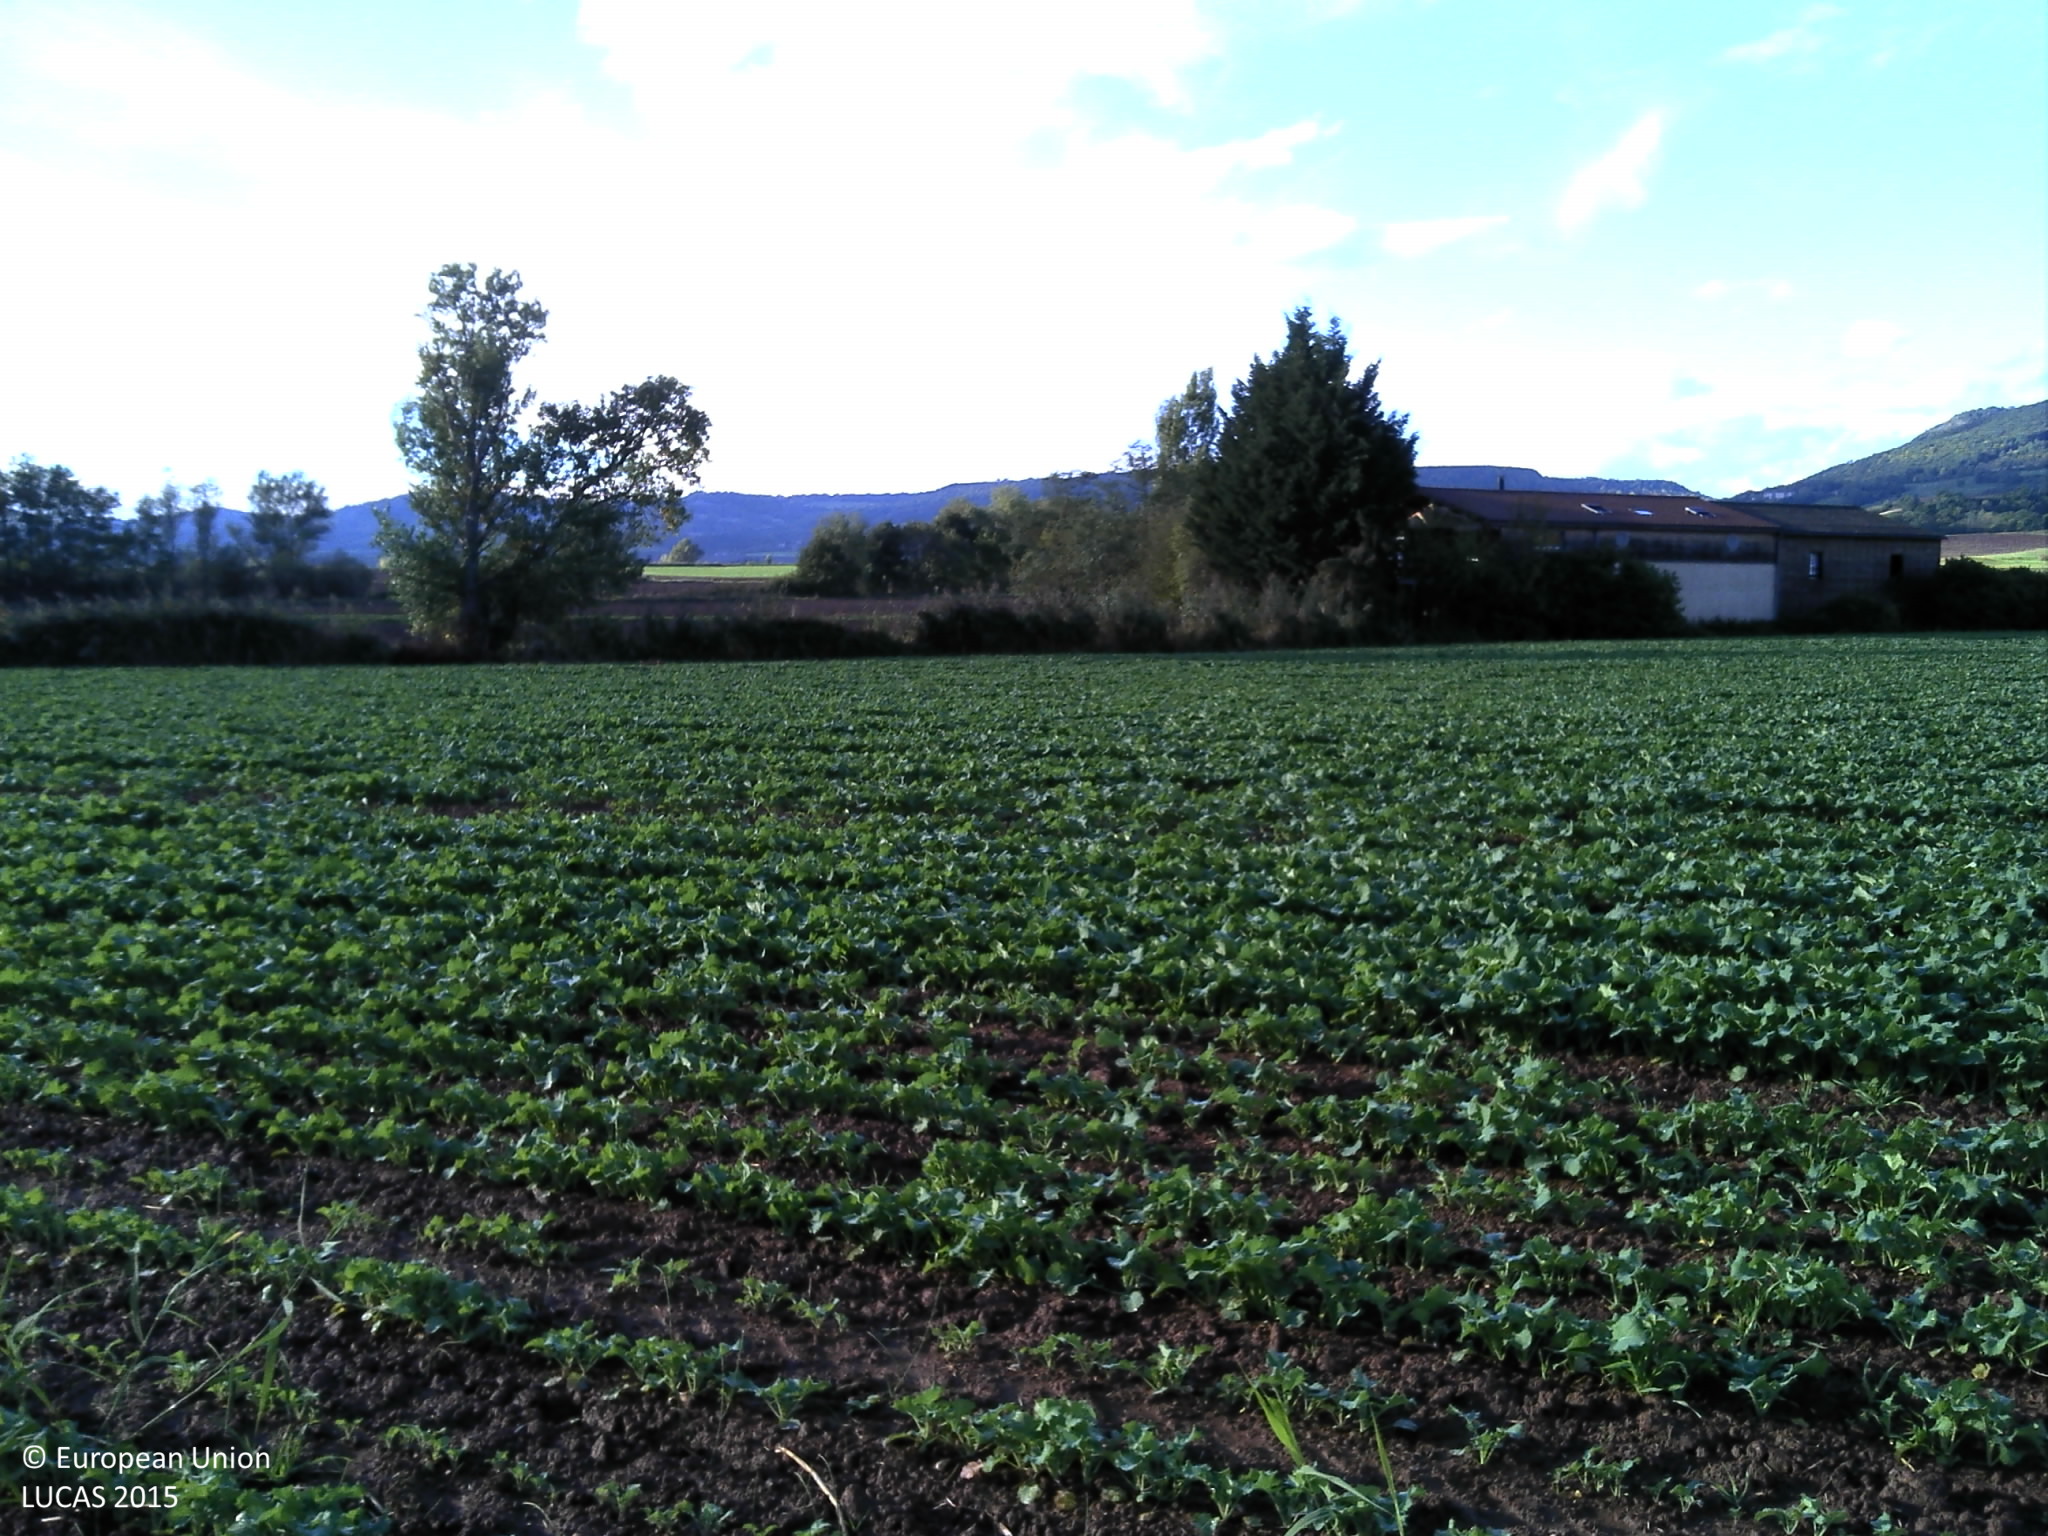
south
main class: Cropland
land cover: Rape and turnip rape
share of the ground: 25 - 50 %
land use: Agriculture (excluding fallow land and kitchen gardens)
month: October
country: FR
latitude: 45.4469
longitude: 3.1864
